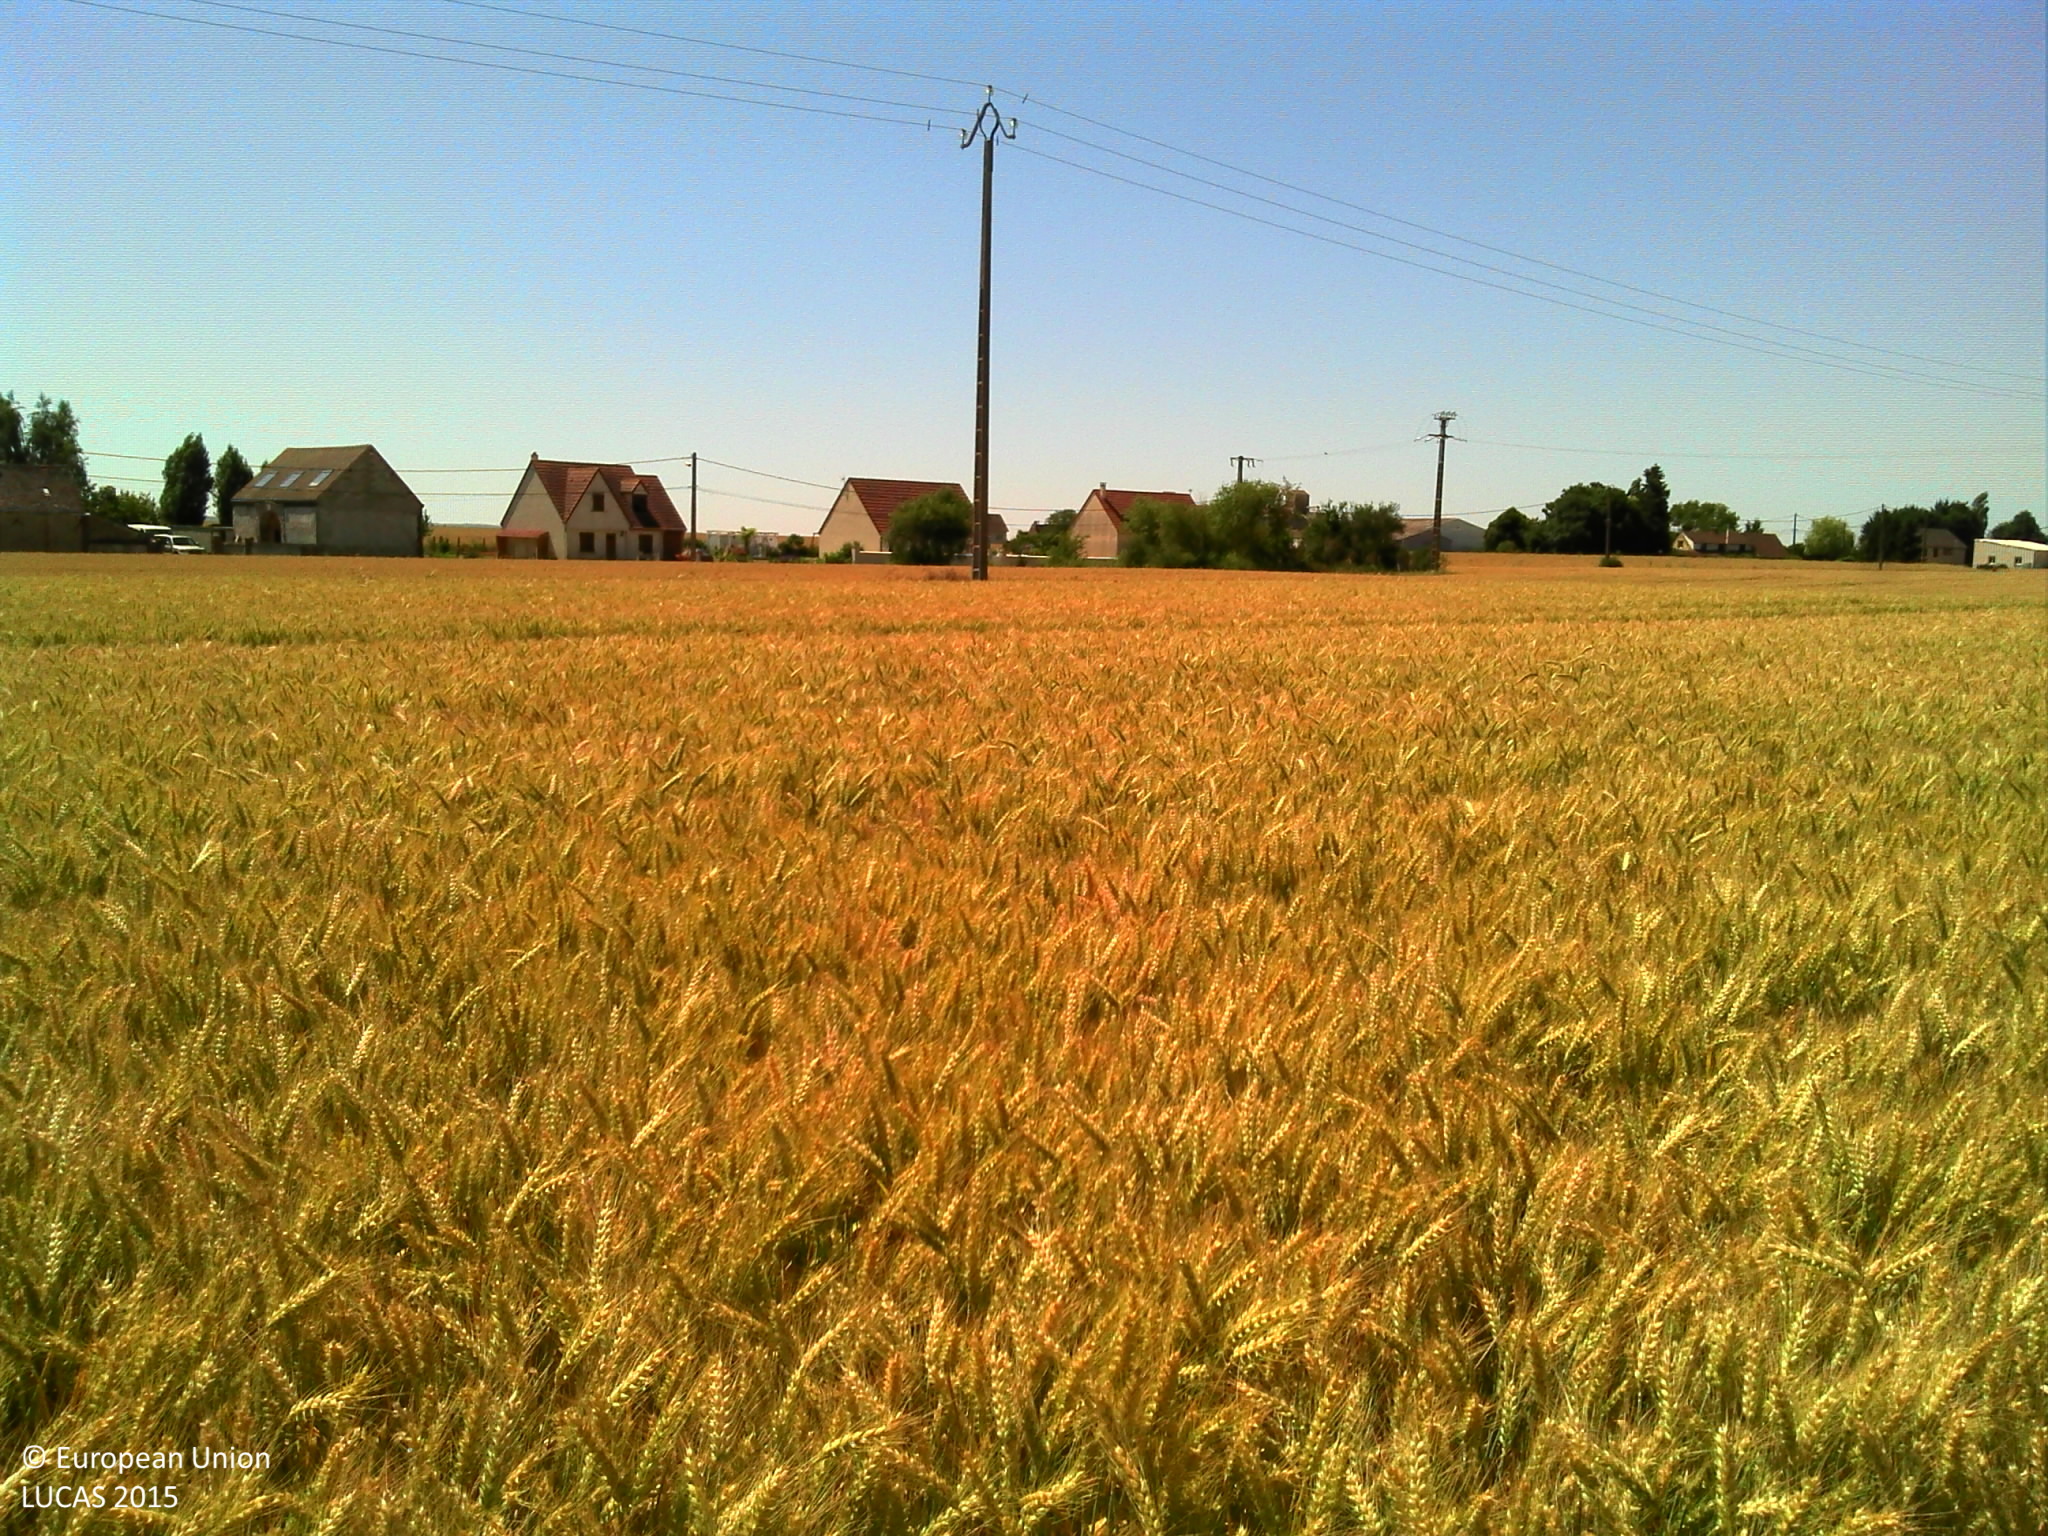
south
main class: Cropland
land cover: Common wheat
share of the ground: > 75 %
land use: Agriculture (excluding fallow land and kitchen gardens)
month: June
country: FR
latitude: 48.6849
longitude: 1.1922
